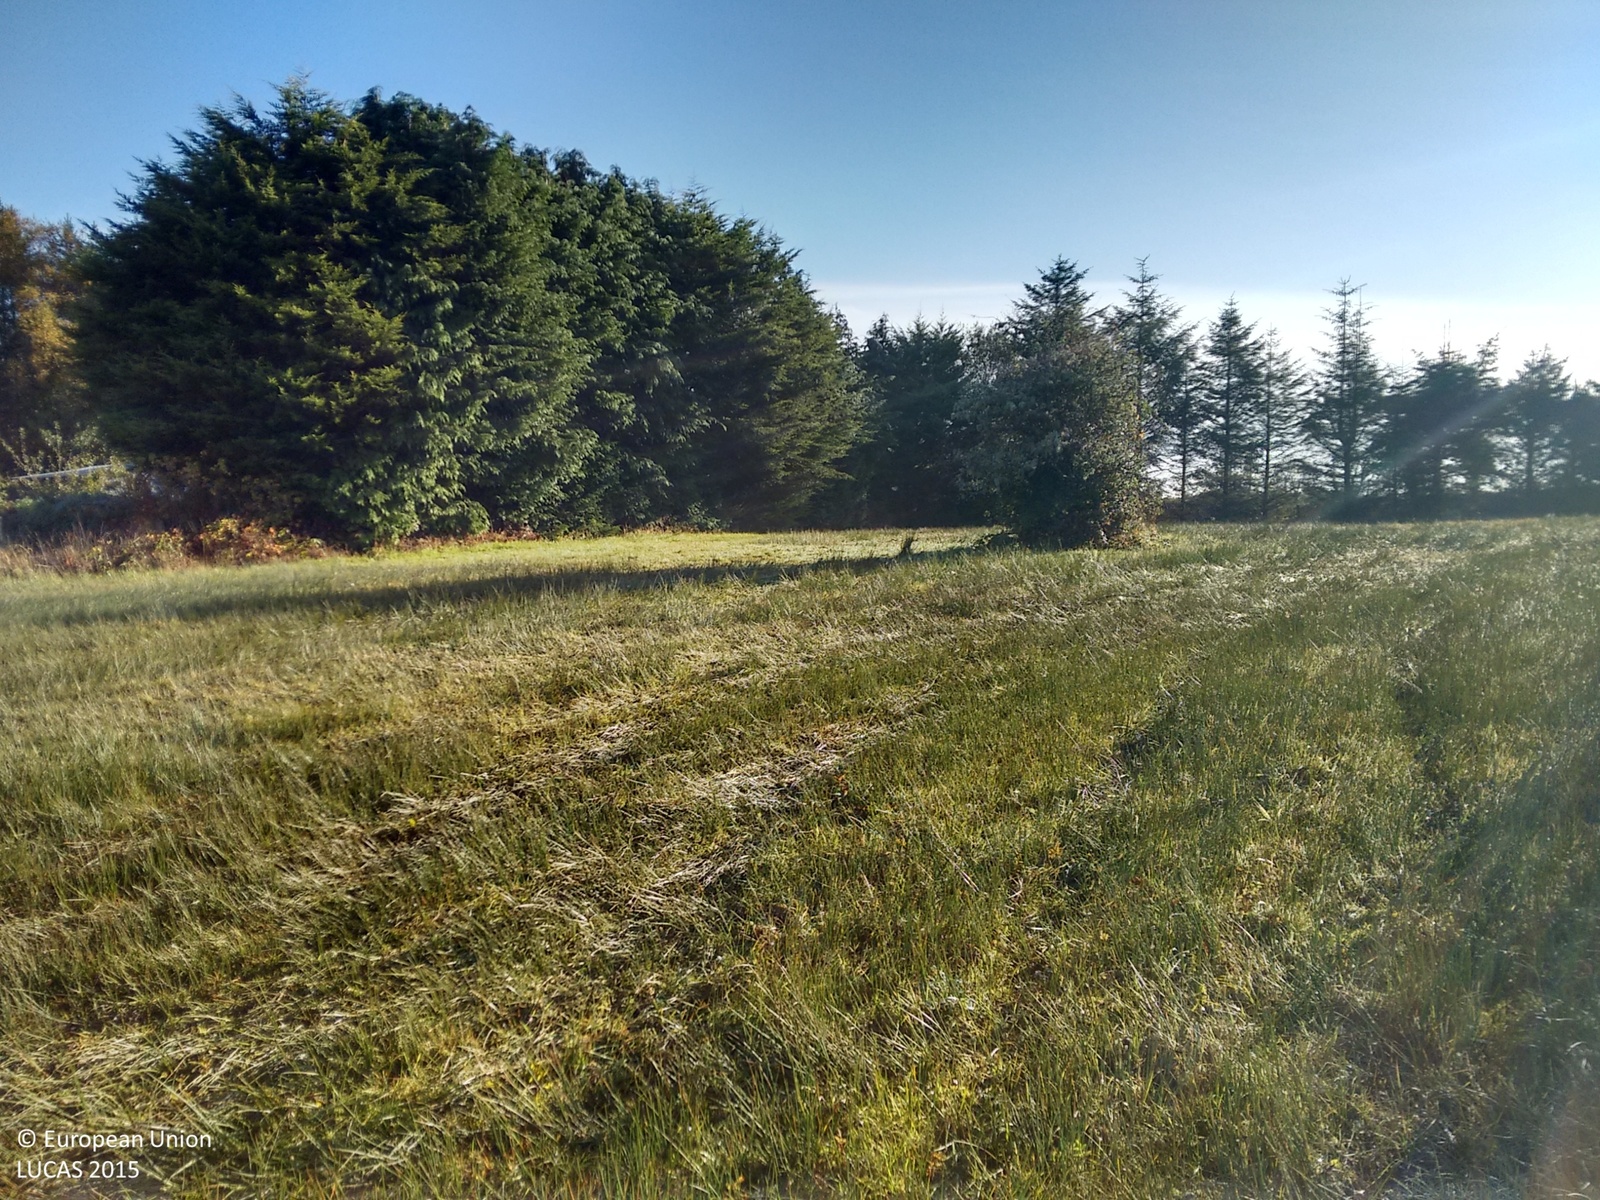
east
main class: Grassland
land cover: Grassland without tree/shrub cover
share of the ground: > 75 %
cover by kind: herbaceous plants 100 %
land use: Agriculture (excluding fallow land and kitchen gardens)
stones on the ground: < 10 %
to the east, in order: Grassland without tree/shrub cover; Abandoned hedges; Artificial constructions in urban areas; Managed hedges; Grassland without tree/shrub cover; Electric lines; Grassland without tree/shrub cover; Abandoned hedges; Grassland without tree/shrub cover; Broadleaved woodland; Grassland without tree/shrub cover; Abandoned hedges; Grassland without tree/shrub cover
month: October
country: IE
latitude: 54.0526
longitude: -8.0949
